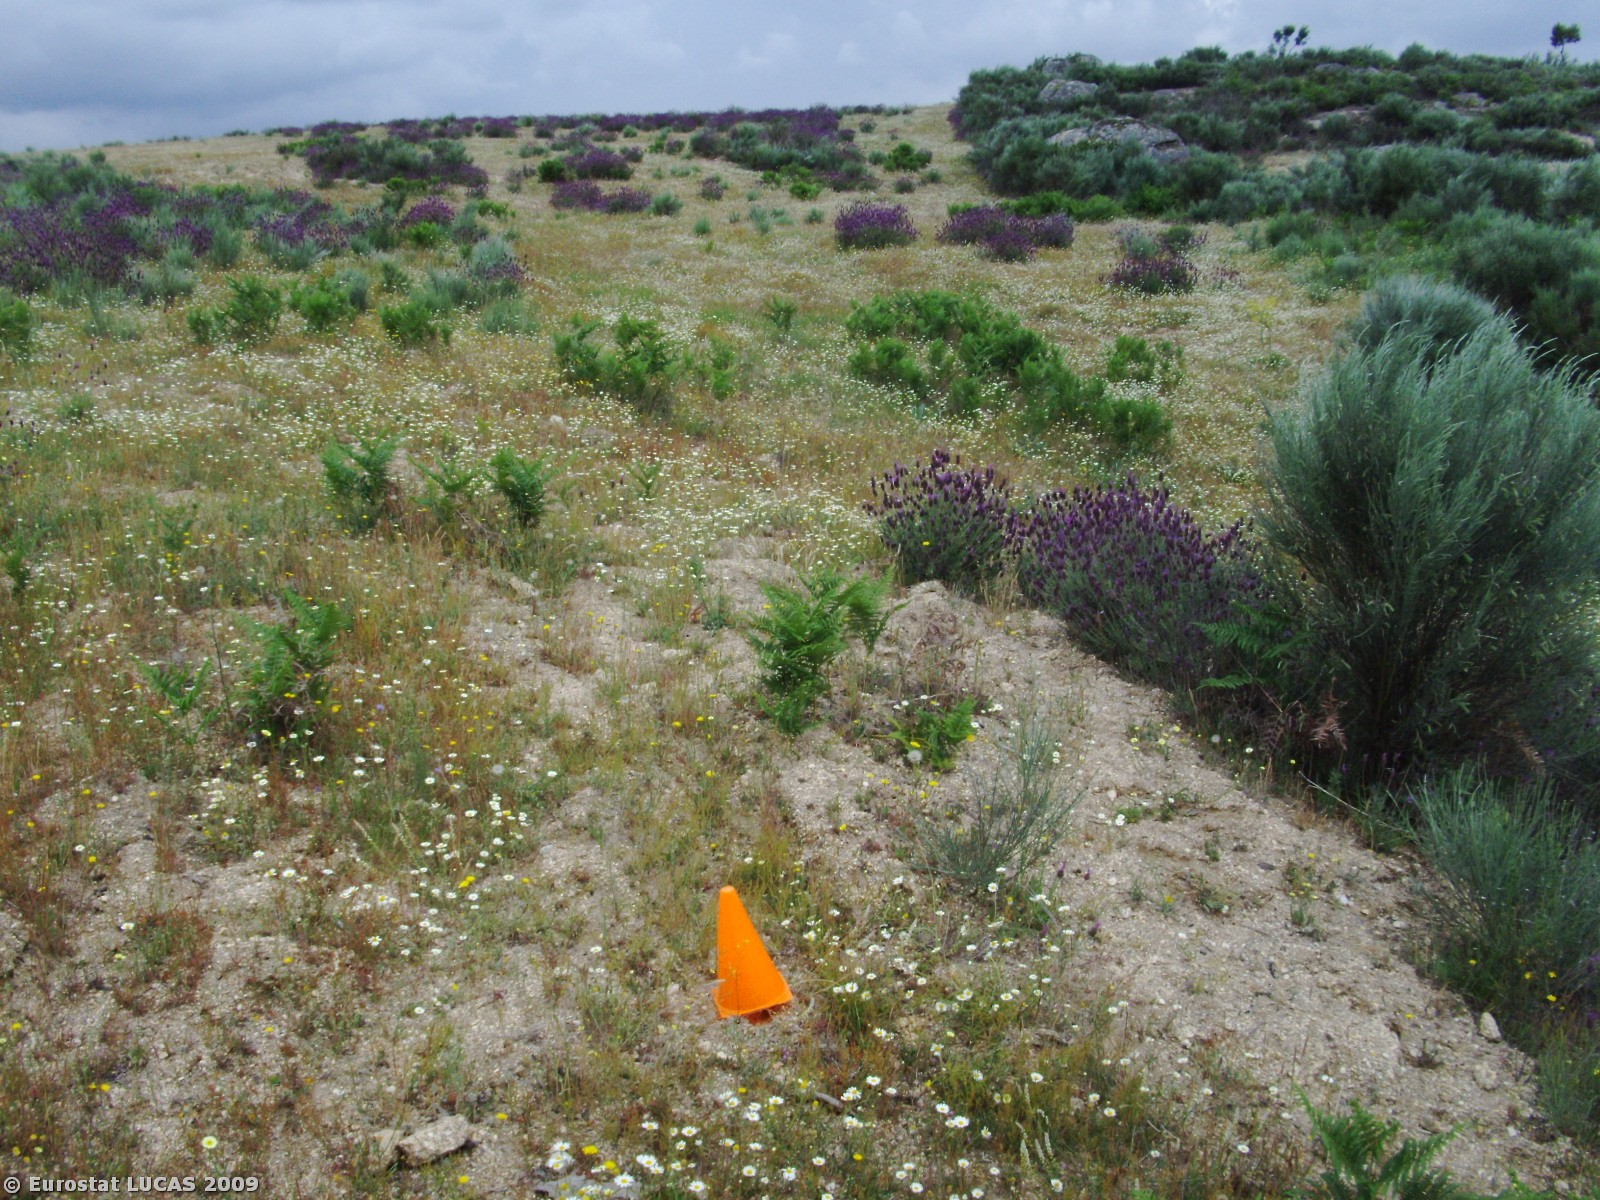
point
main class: Grassland
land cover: Spontaneously vegetated surfaces
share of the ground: > 75 %
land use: Fallow land
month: May
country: PT
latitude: 40.6947
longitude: -7.2799
